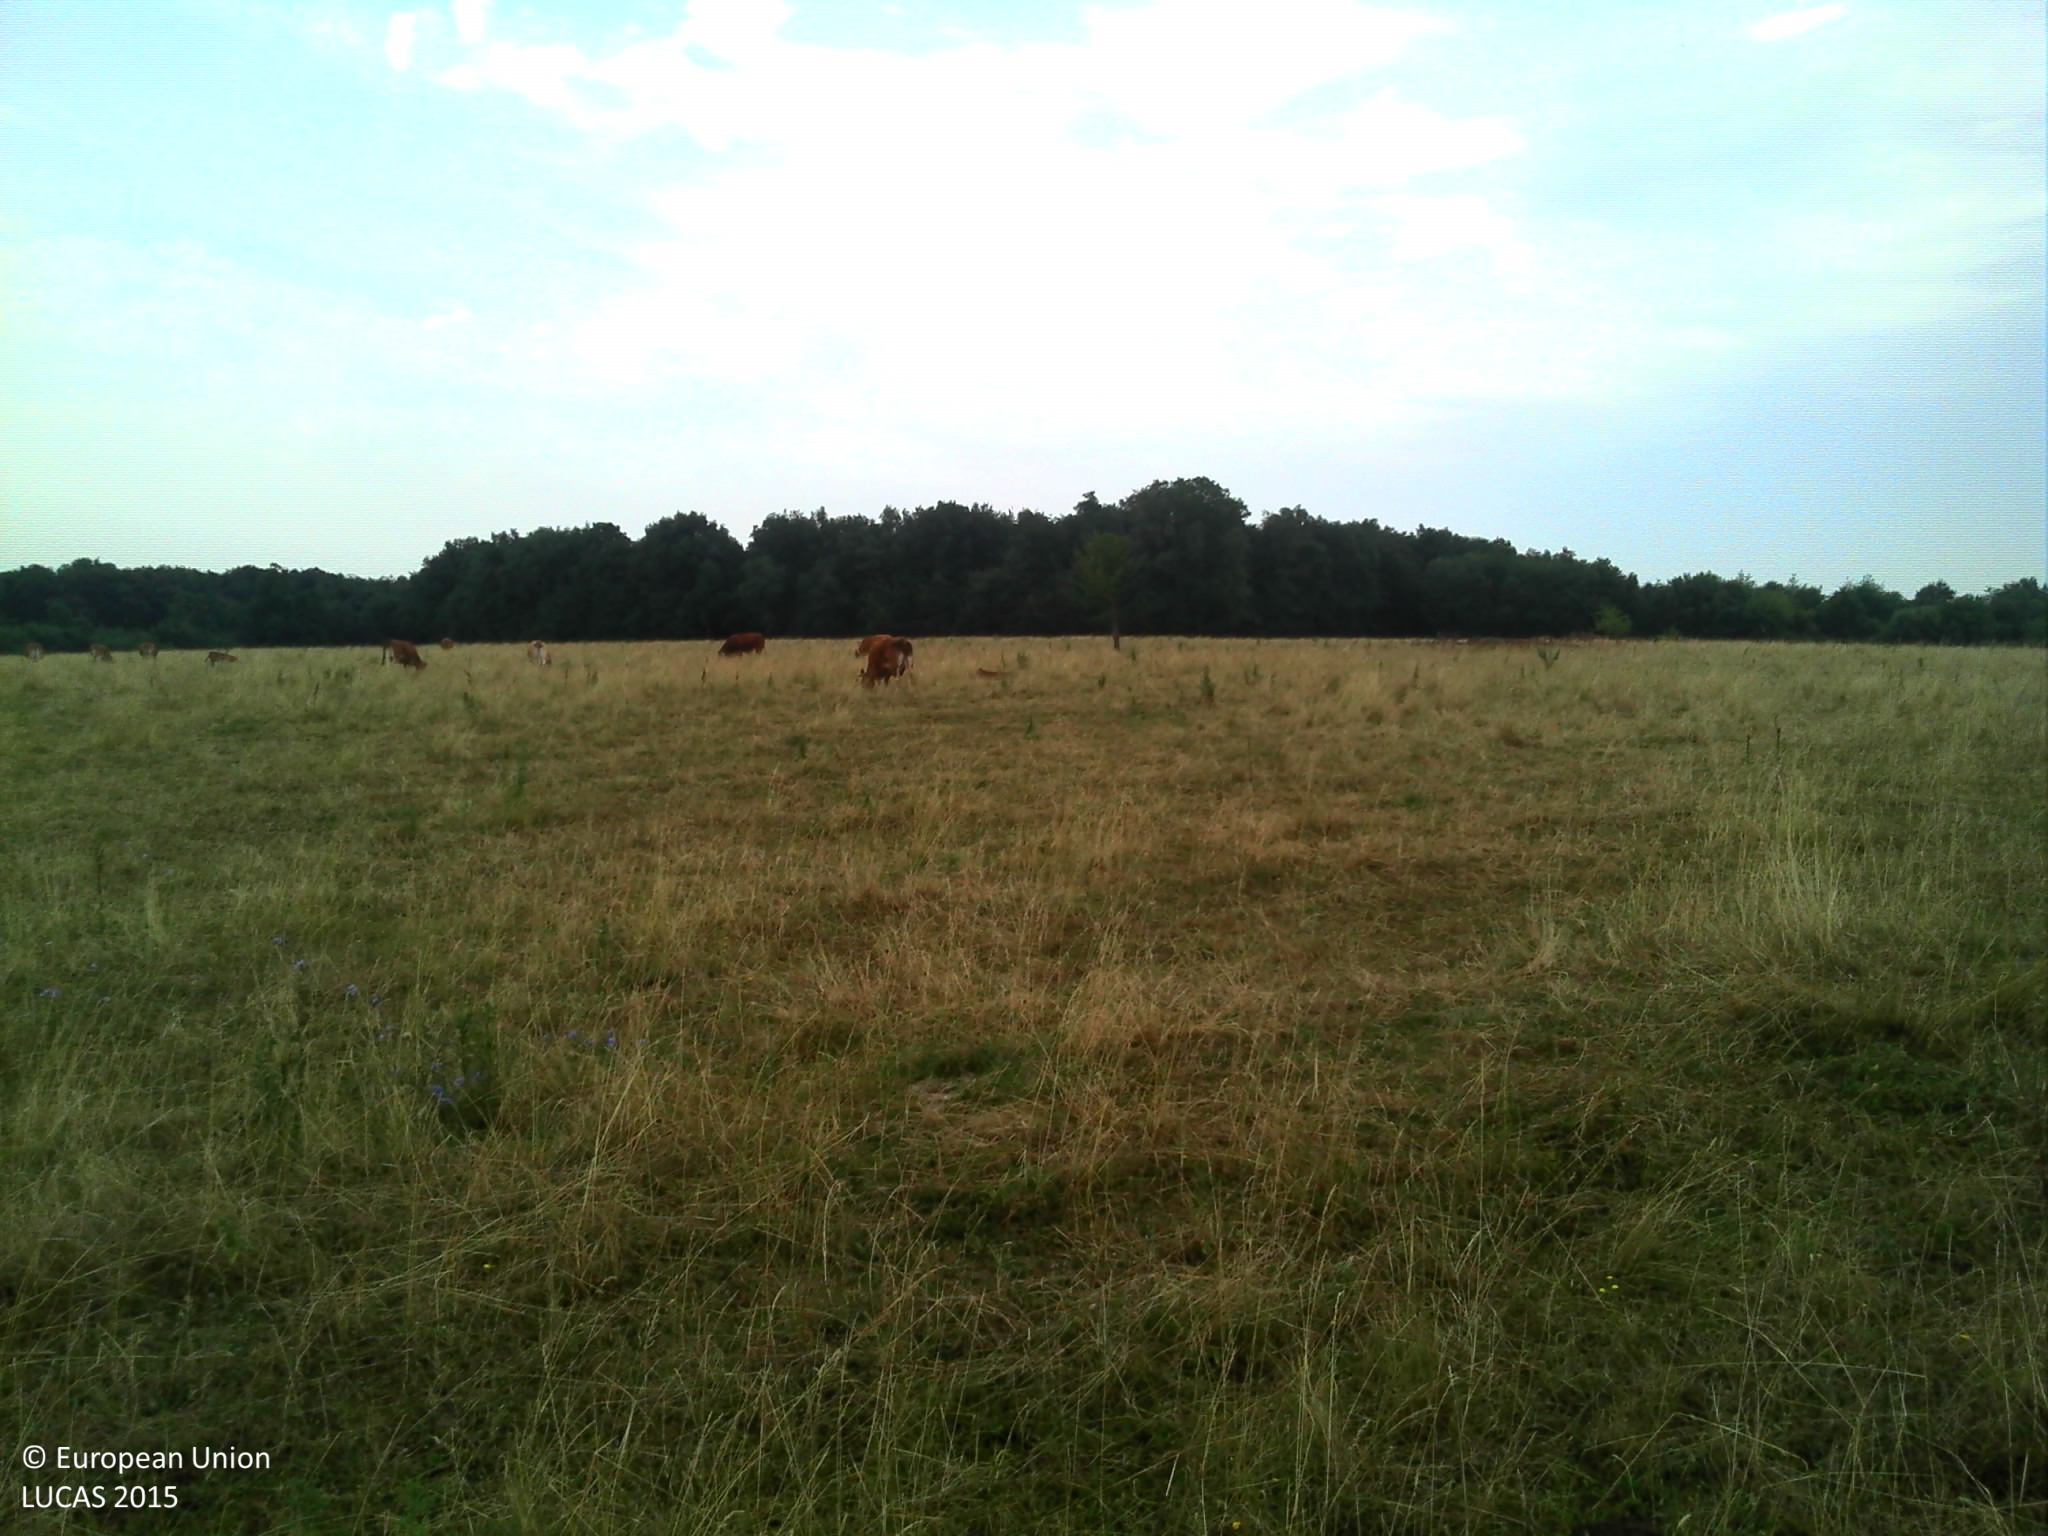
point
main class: Grassland
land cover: Grassland without tree/shrub cover
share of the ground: > 75 %
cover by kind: herbaceous plants 100 %
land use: Agriculture (excluding fallow land and kitchen gardens)
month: July
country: FR
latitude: 46.4283
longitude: 0.6274
